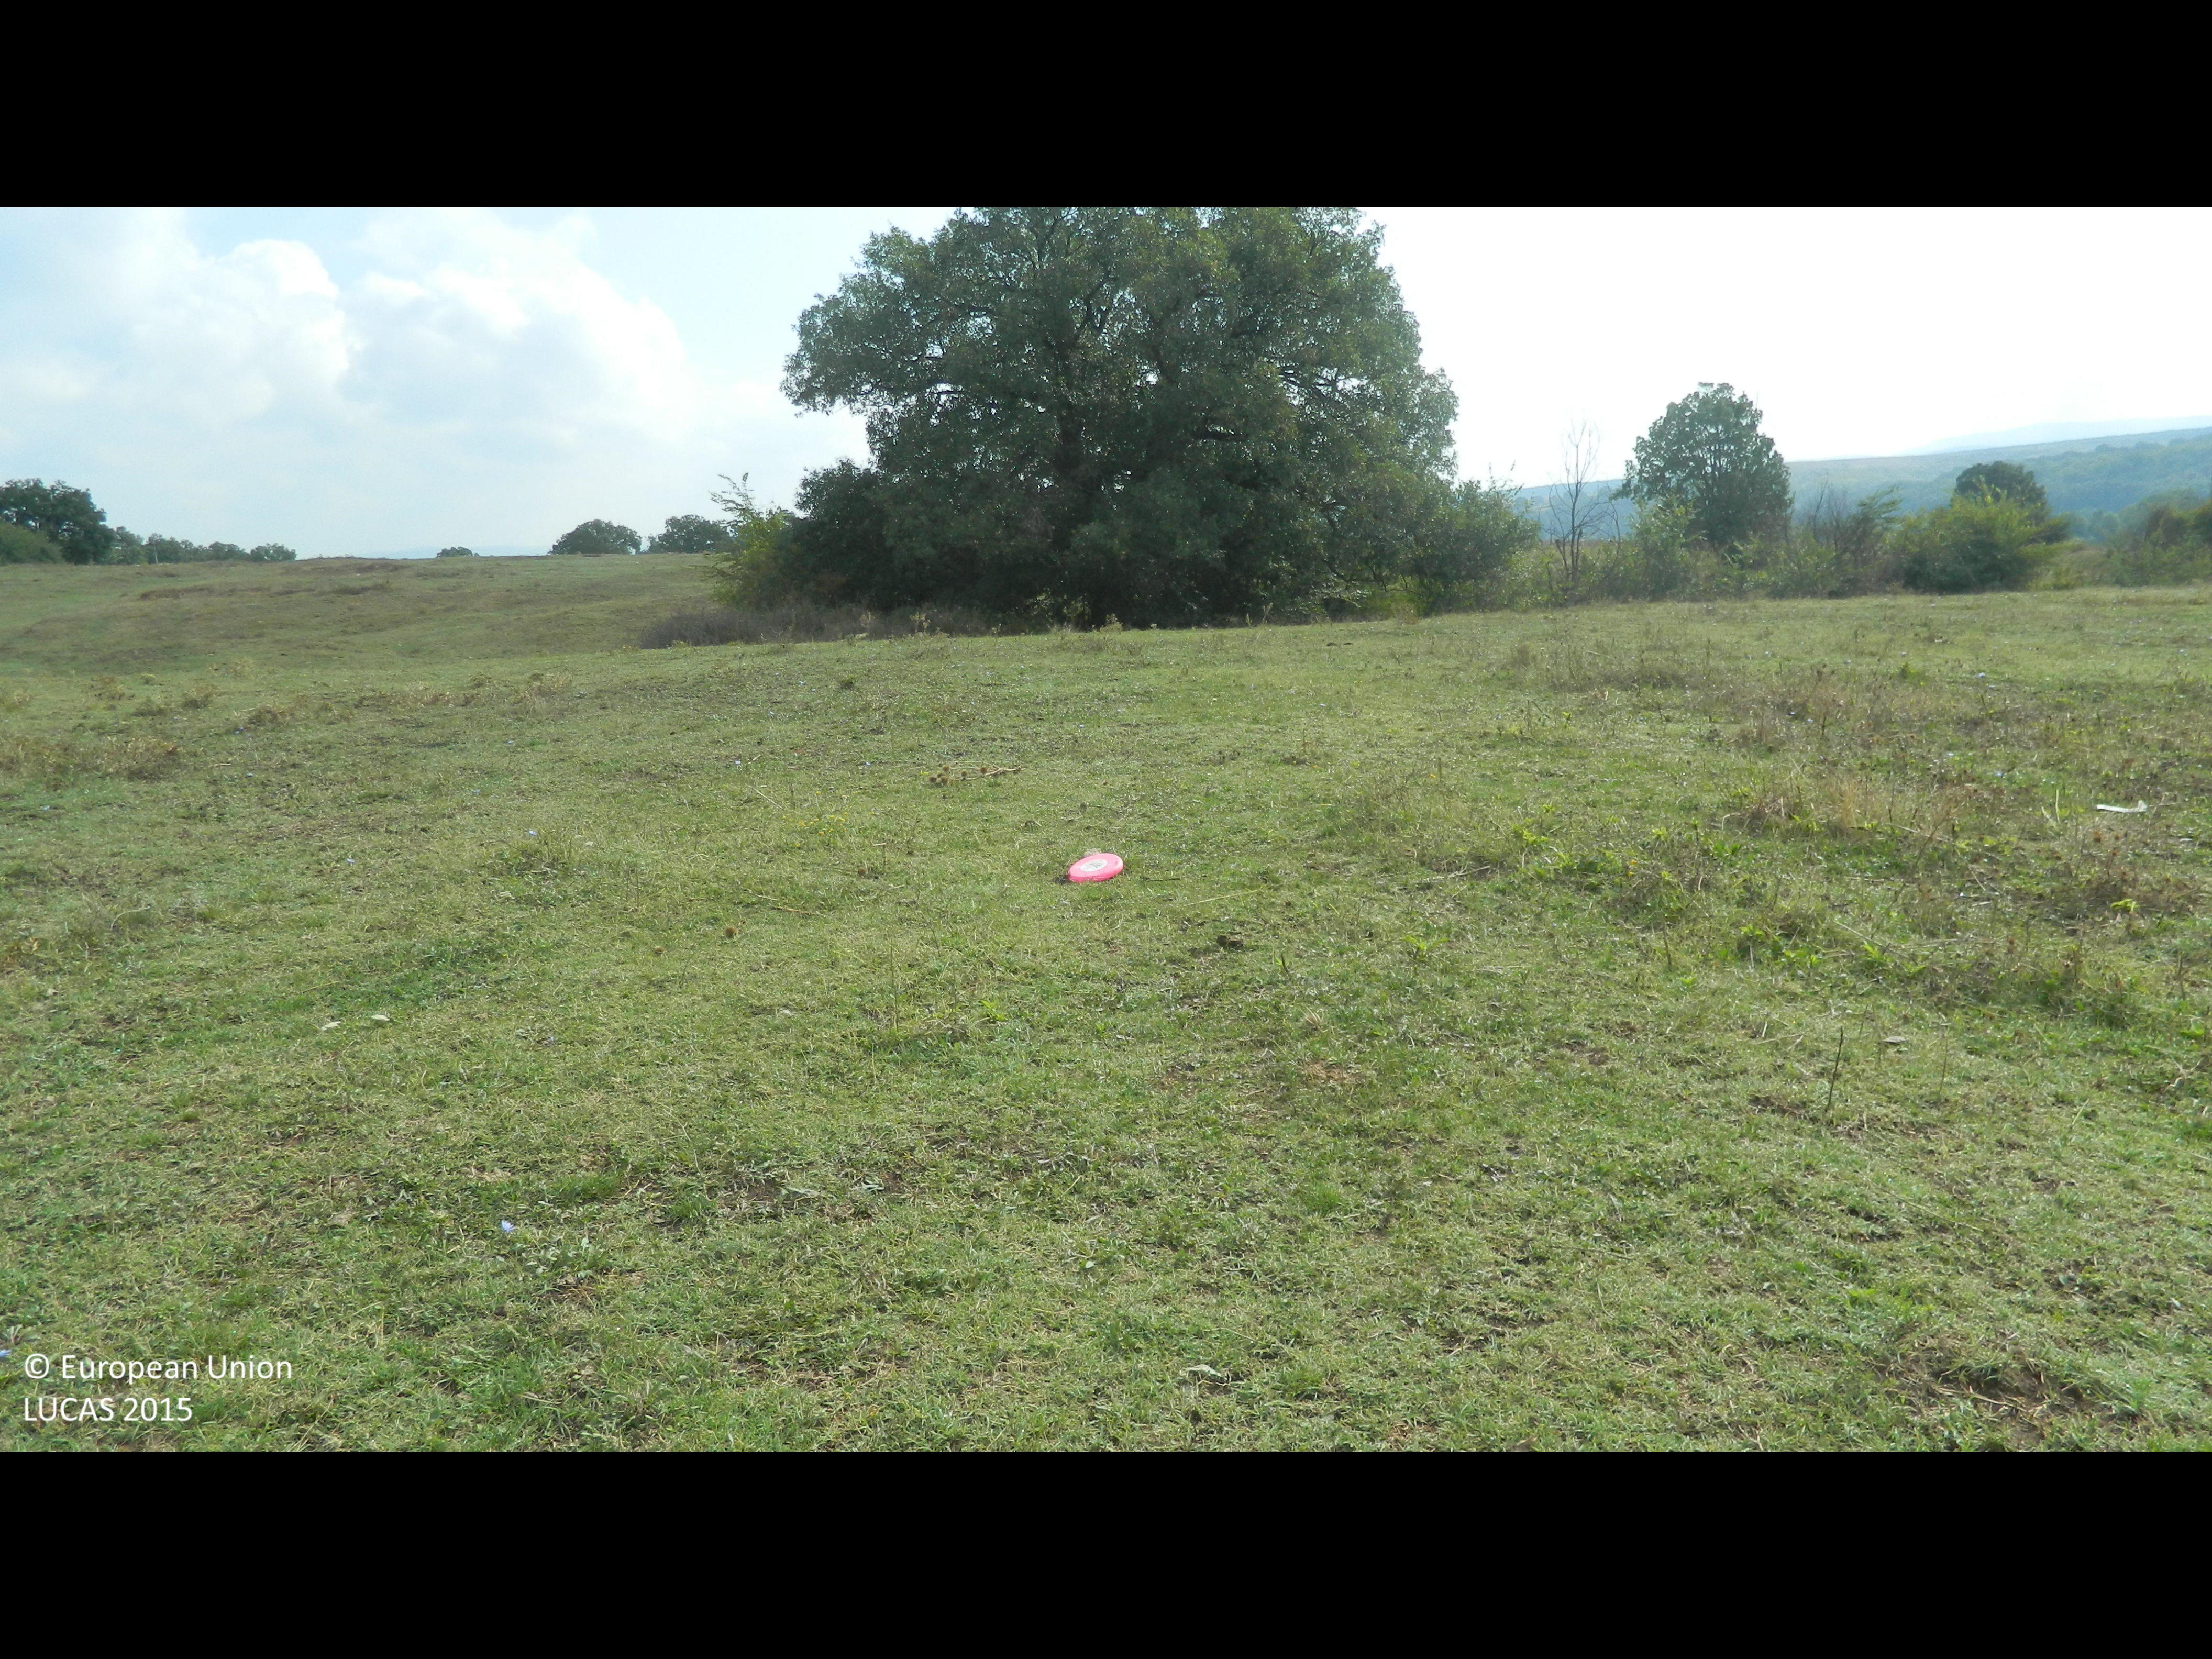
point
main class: Grassland
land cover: Grassland without tree/shrub cover
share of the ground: > 75 %
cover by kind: herbaceous plants 100 %
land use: Agriculture (excluding fallow land and kitchen gardens)
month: September
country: BG
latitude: 41.8249
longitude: 25.5828
